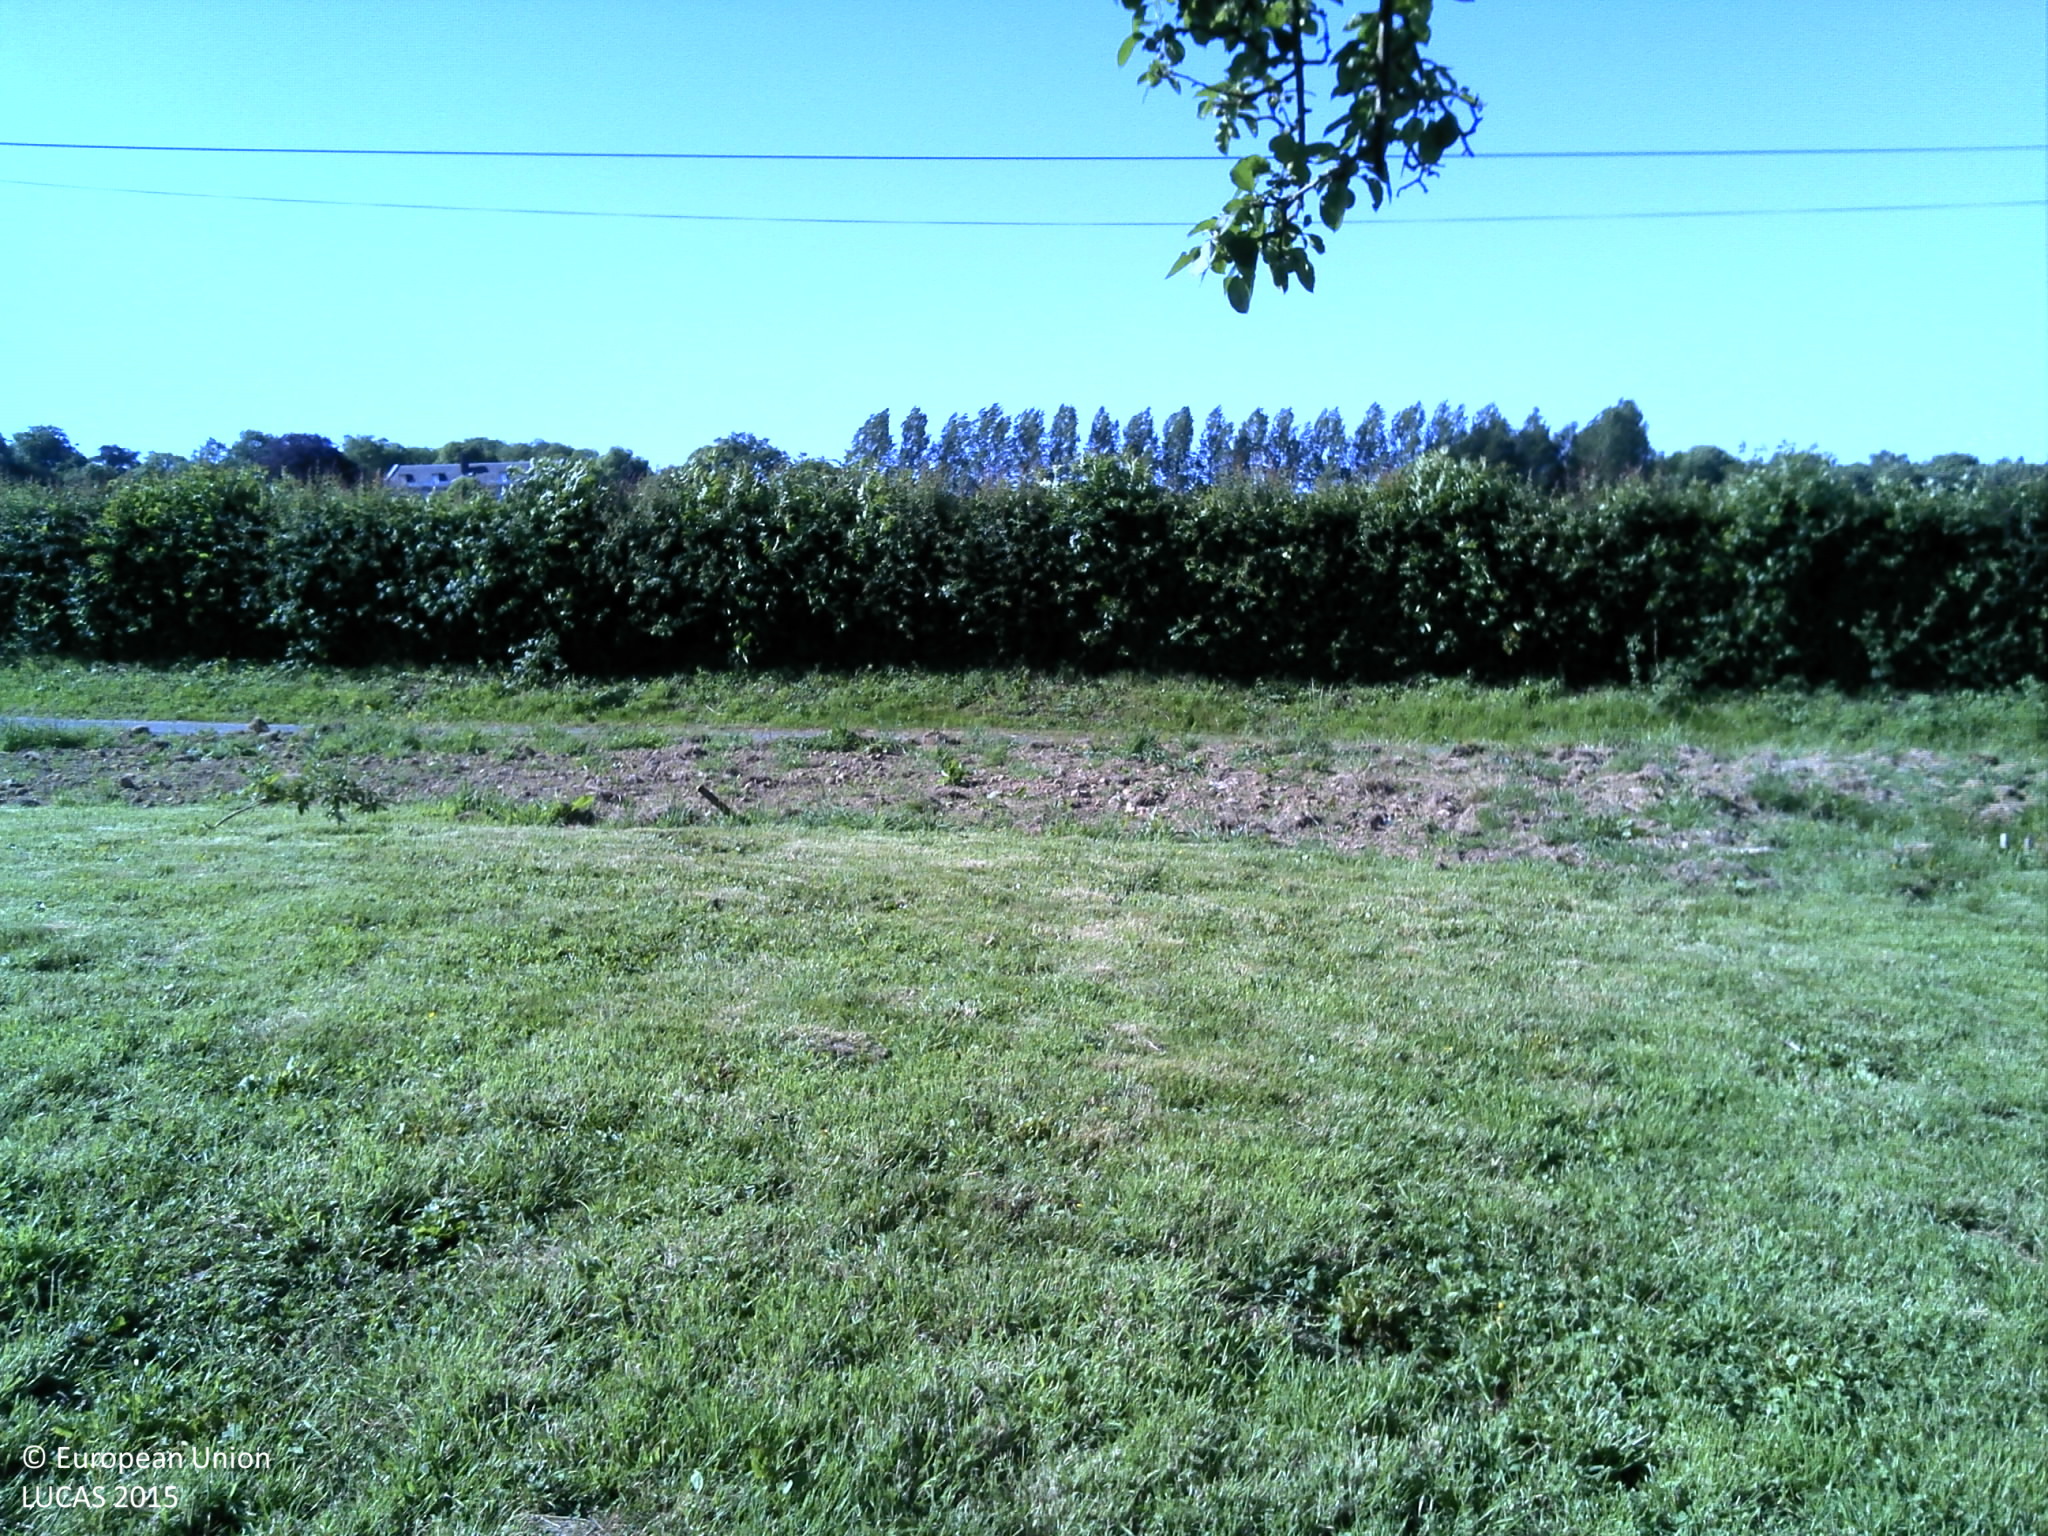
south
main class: Grassland
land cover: Grassland with sparse tree/shrub cover
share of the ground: > 75 %
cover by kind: herbaceous plants 95 %, broadleaved forest trees 5 %
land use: Residential
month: June
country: FR
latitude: 49.5833
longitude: 1.1125
